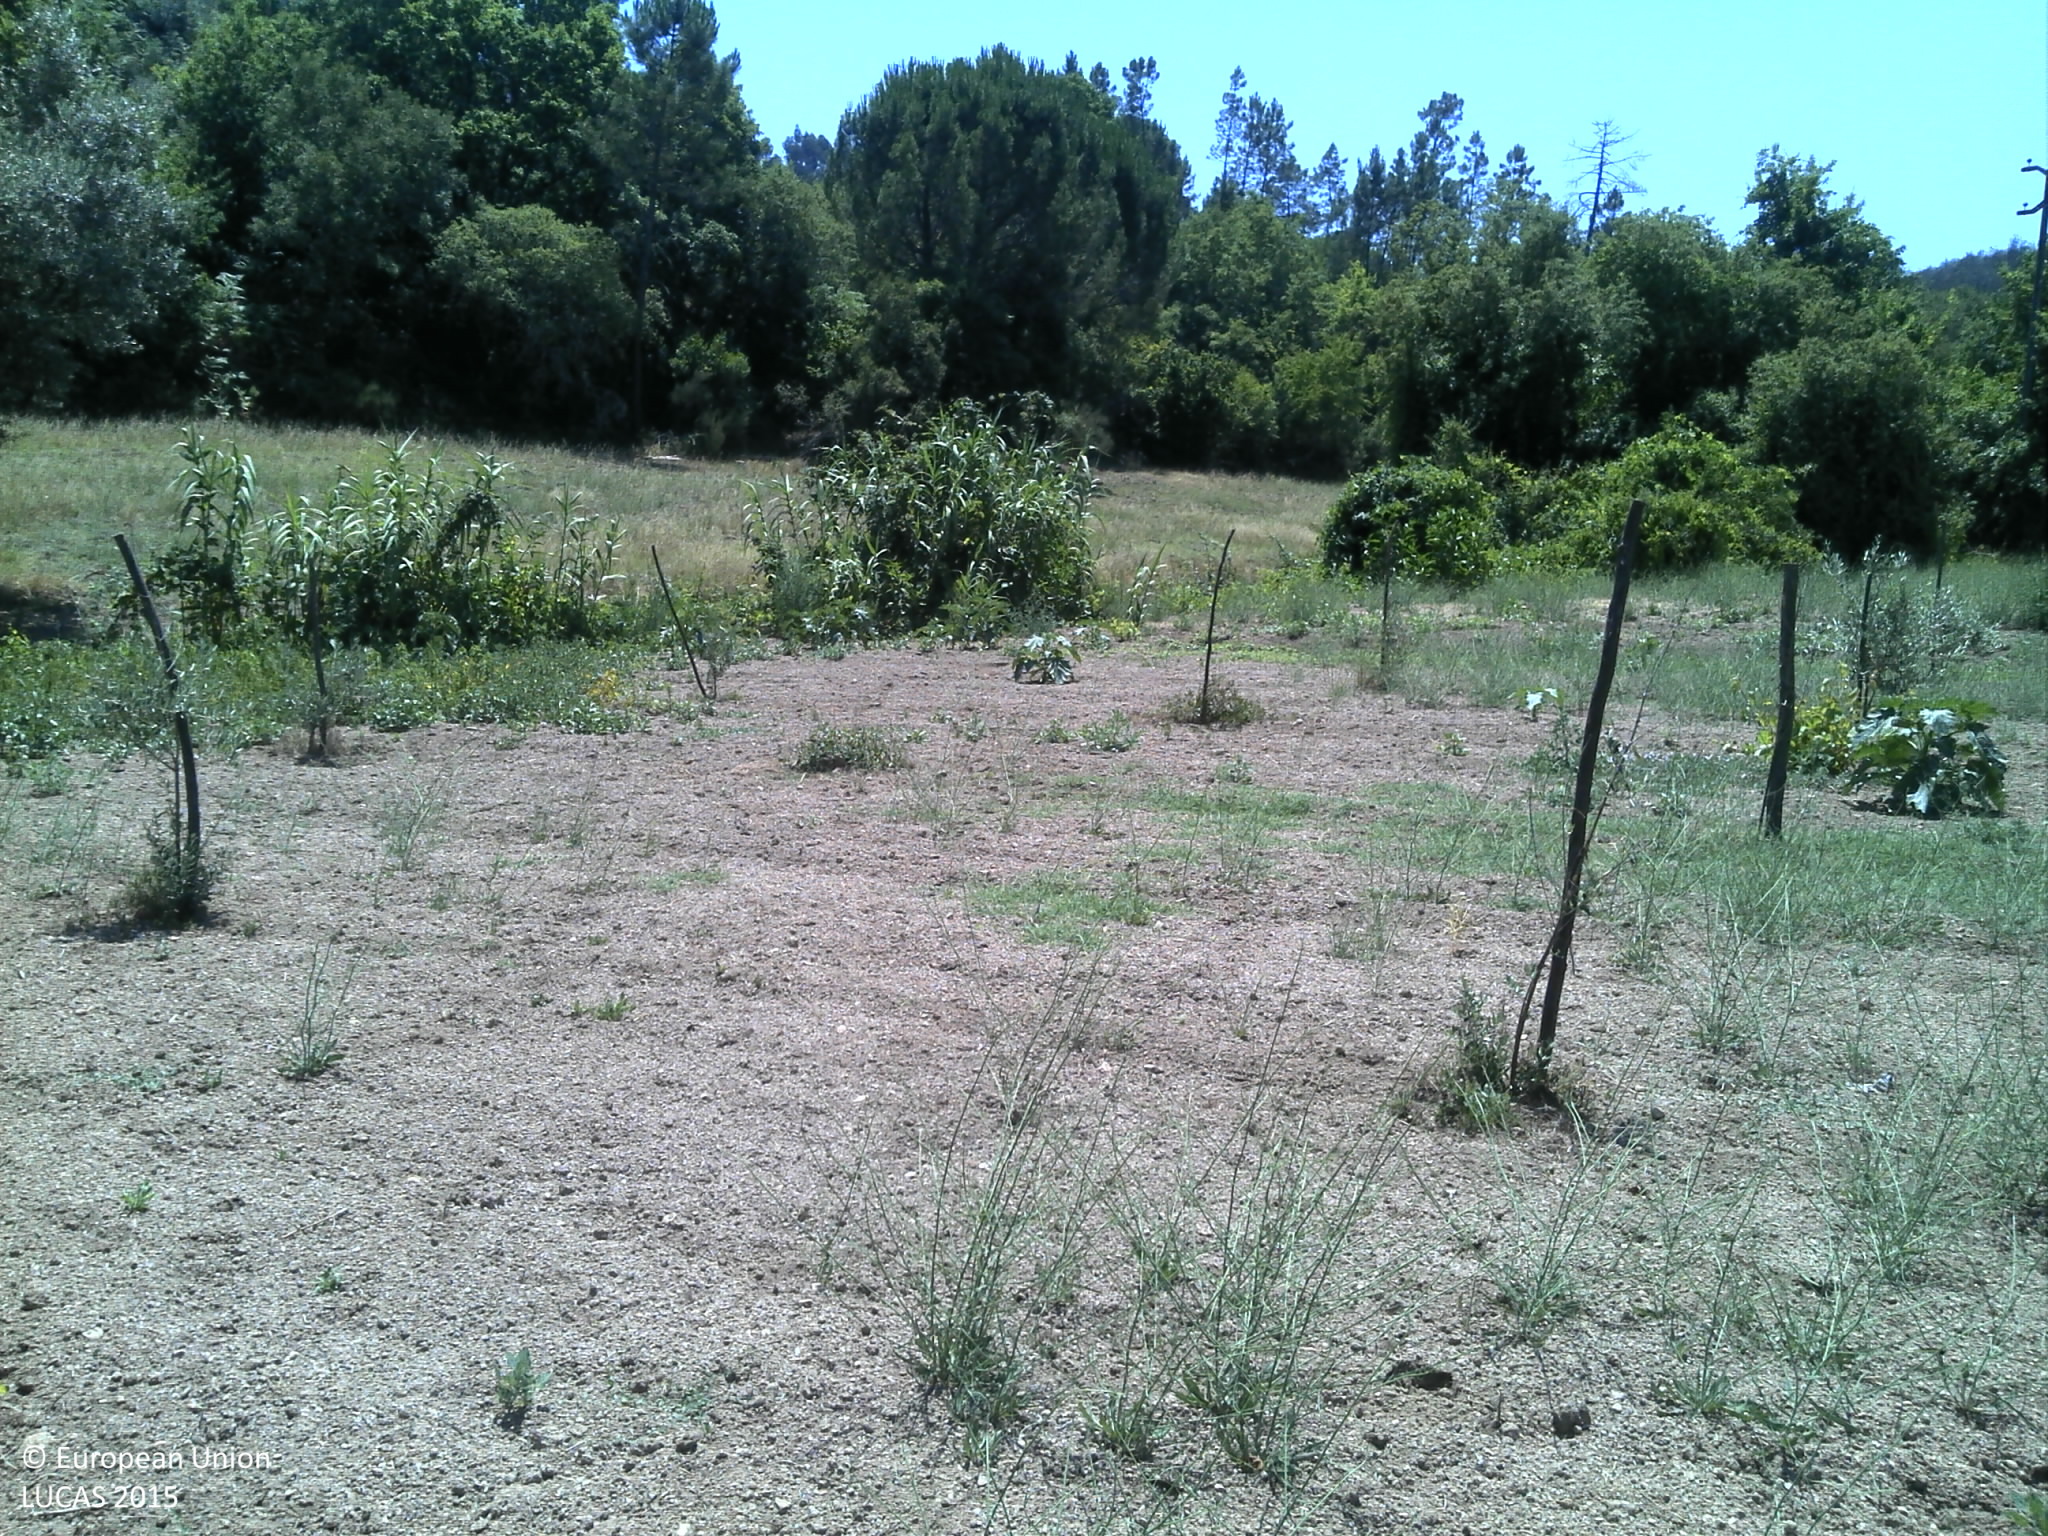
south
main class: Cropland
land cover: Other leguminous and mixtures for fodder
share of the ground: < 10 %
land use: Agriculture (excluding fallow land and kitchen gardens)
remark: Harvested field
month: July
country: PT
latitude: 40.3768
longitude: -8.0134
